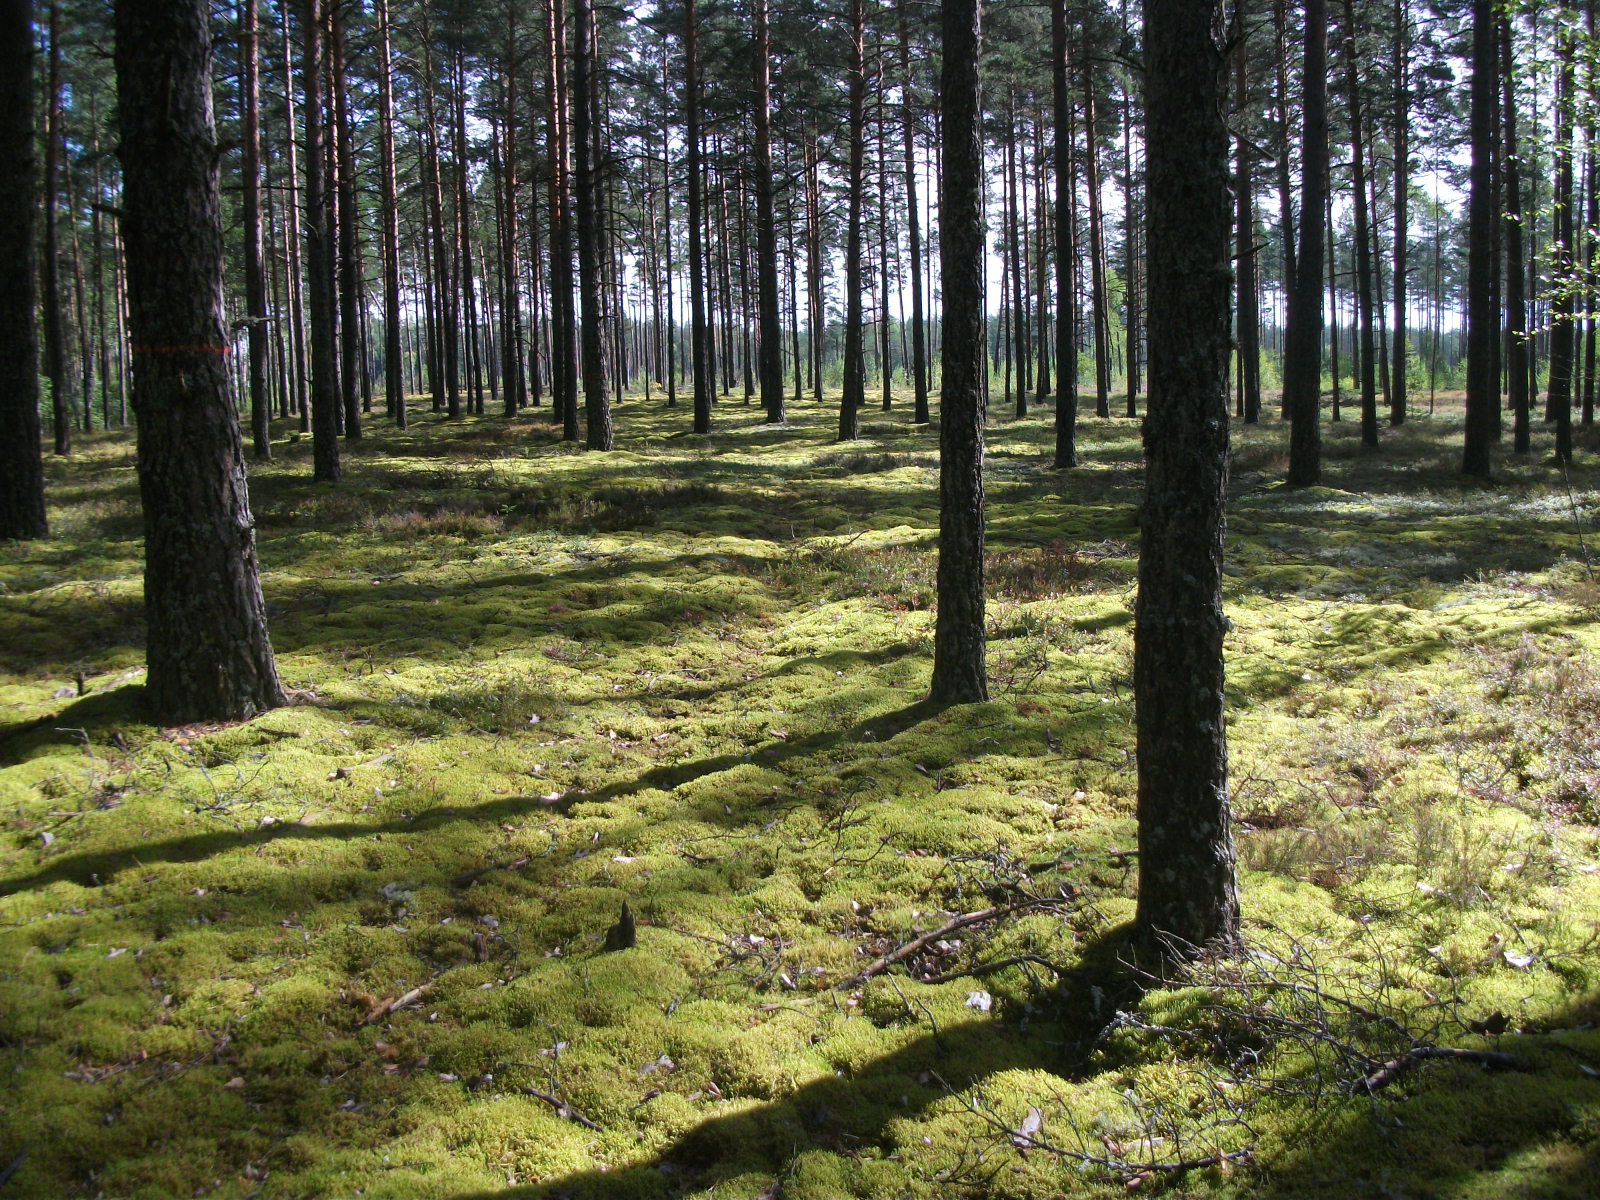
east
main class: Woodland
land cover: Pine dominated coniferous woodland
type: hemiboreal forest and nemoral coniferous forest and mixed broadleaved-coniferous forest
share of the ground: 50 - 75 %
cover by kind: coniferous forest trees 65 %, lichens and mosses 35 %
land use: Forestry
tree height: > 5 m
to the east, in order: Pine dominated coniferous woodland; Other mixed woodland; Tracks; Other mixed woodland; Pine dominated coniferous woodland; Pine dominated mixed woodland
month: August
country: LV
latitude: 56.5058
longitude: 26.5097
